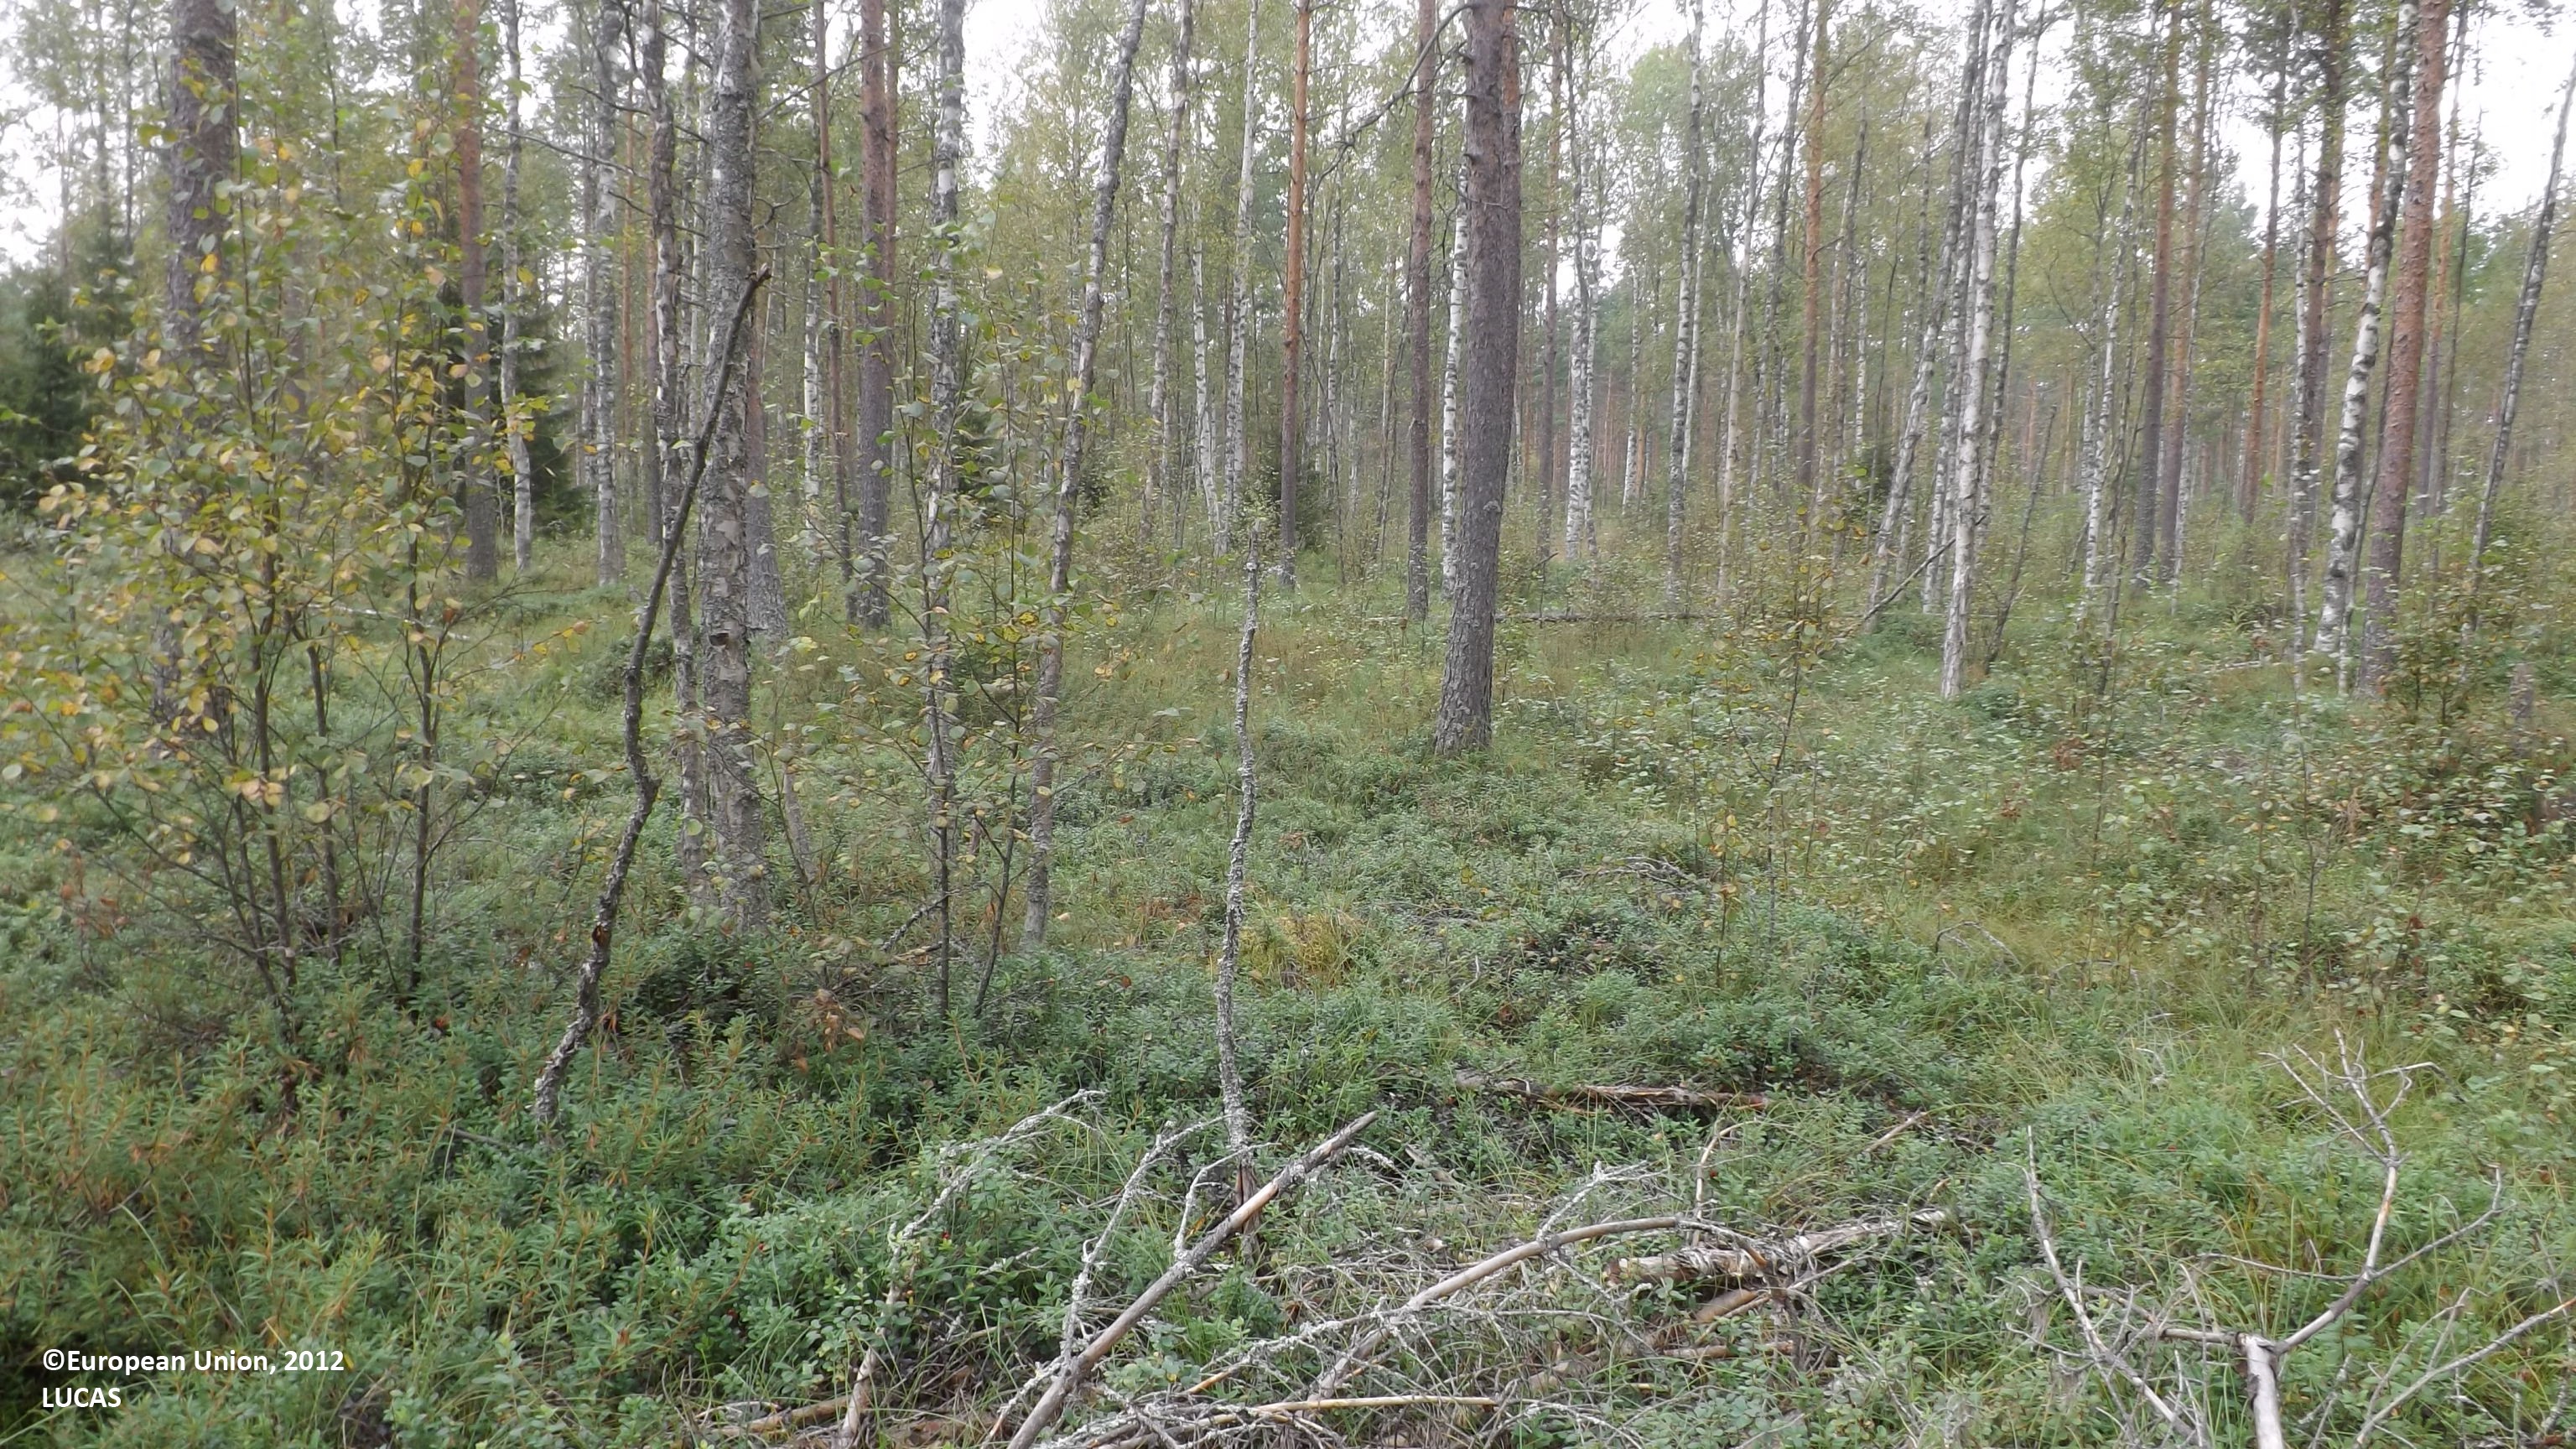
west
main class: Woodland
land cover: Pine dominated mixed woodland
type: boreal forest
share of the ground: 50 - 75 %
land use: Forestry
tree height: > 5 m
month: August
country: FI
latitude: 63.9005
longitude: 23.8153
